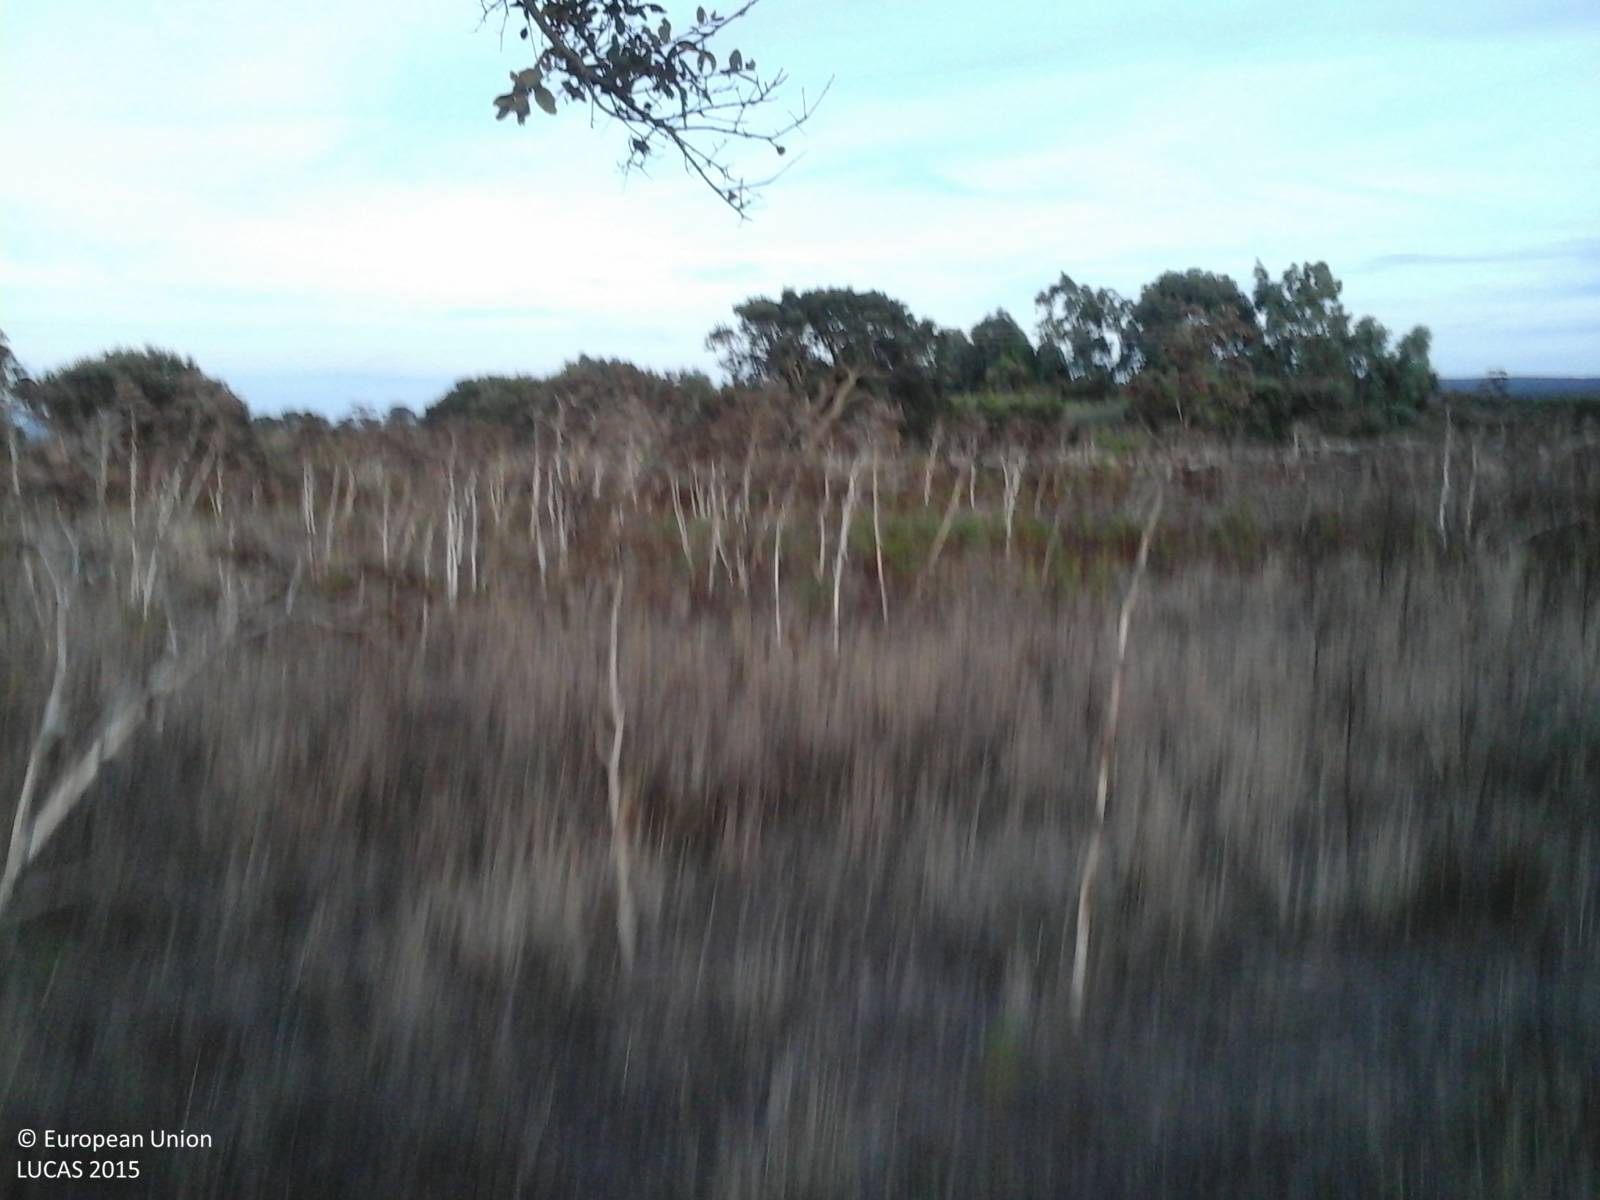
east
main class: Grassland
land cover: Spontaneously vegetated surfaces
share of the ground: > 75 %
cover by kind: herbaceous plants 100 %
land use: Agriculture (excluding fallow land and kitchen gardens)
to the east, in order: Spontaneously vegetated surfaces; Dry stone walls; Grassland with sparse tree/shrub cover; Broadleaved woodland; Dry stone walls; Tracks; Abandoned hedges; Grassland without tree/shrub cover; Electric lines; Grassland without tree/shrub cover; Single bushes/trees; Grassland without tree/shrub cover
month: October
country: IT
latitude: 40.2752
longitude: 8.5843
